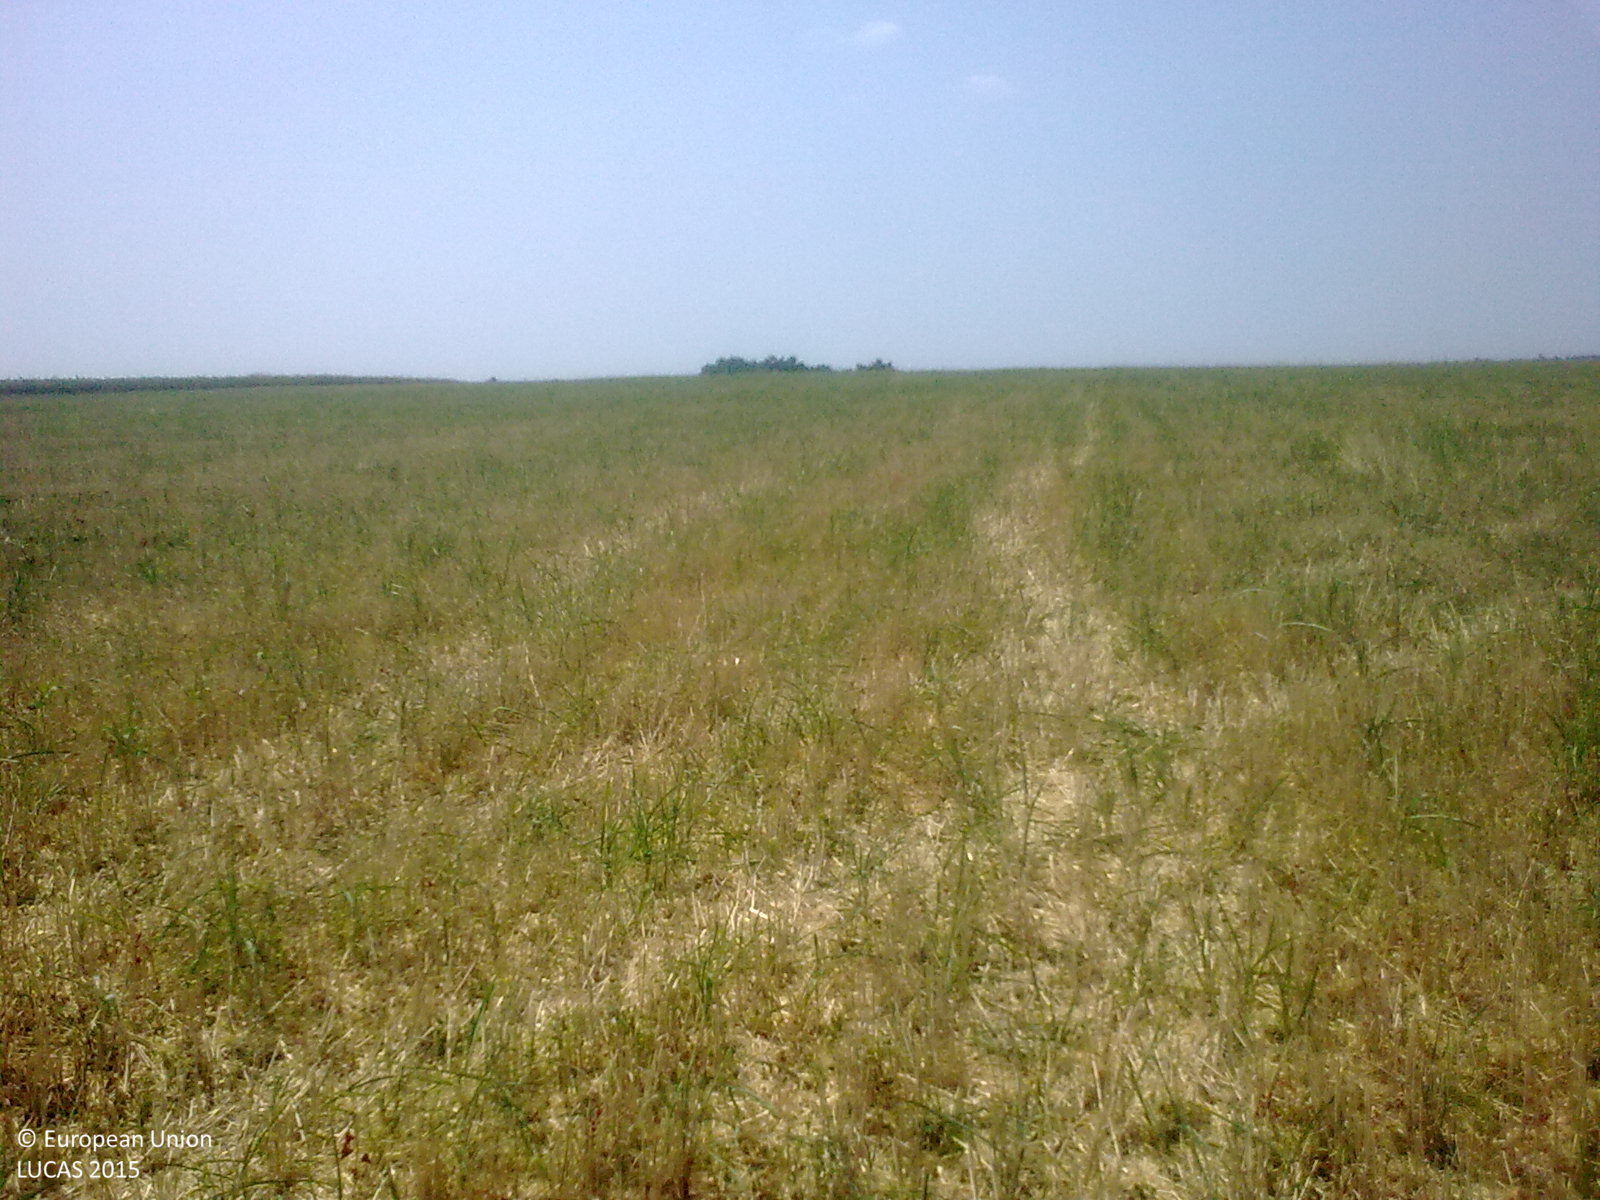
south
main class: Cropland
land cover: Common wheat
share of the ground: 50 - 75 %
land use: Agriculture (excluding fallow land and kitchen gardens)
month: July
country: BG
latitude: 43.6025
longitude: 25.8358
